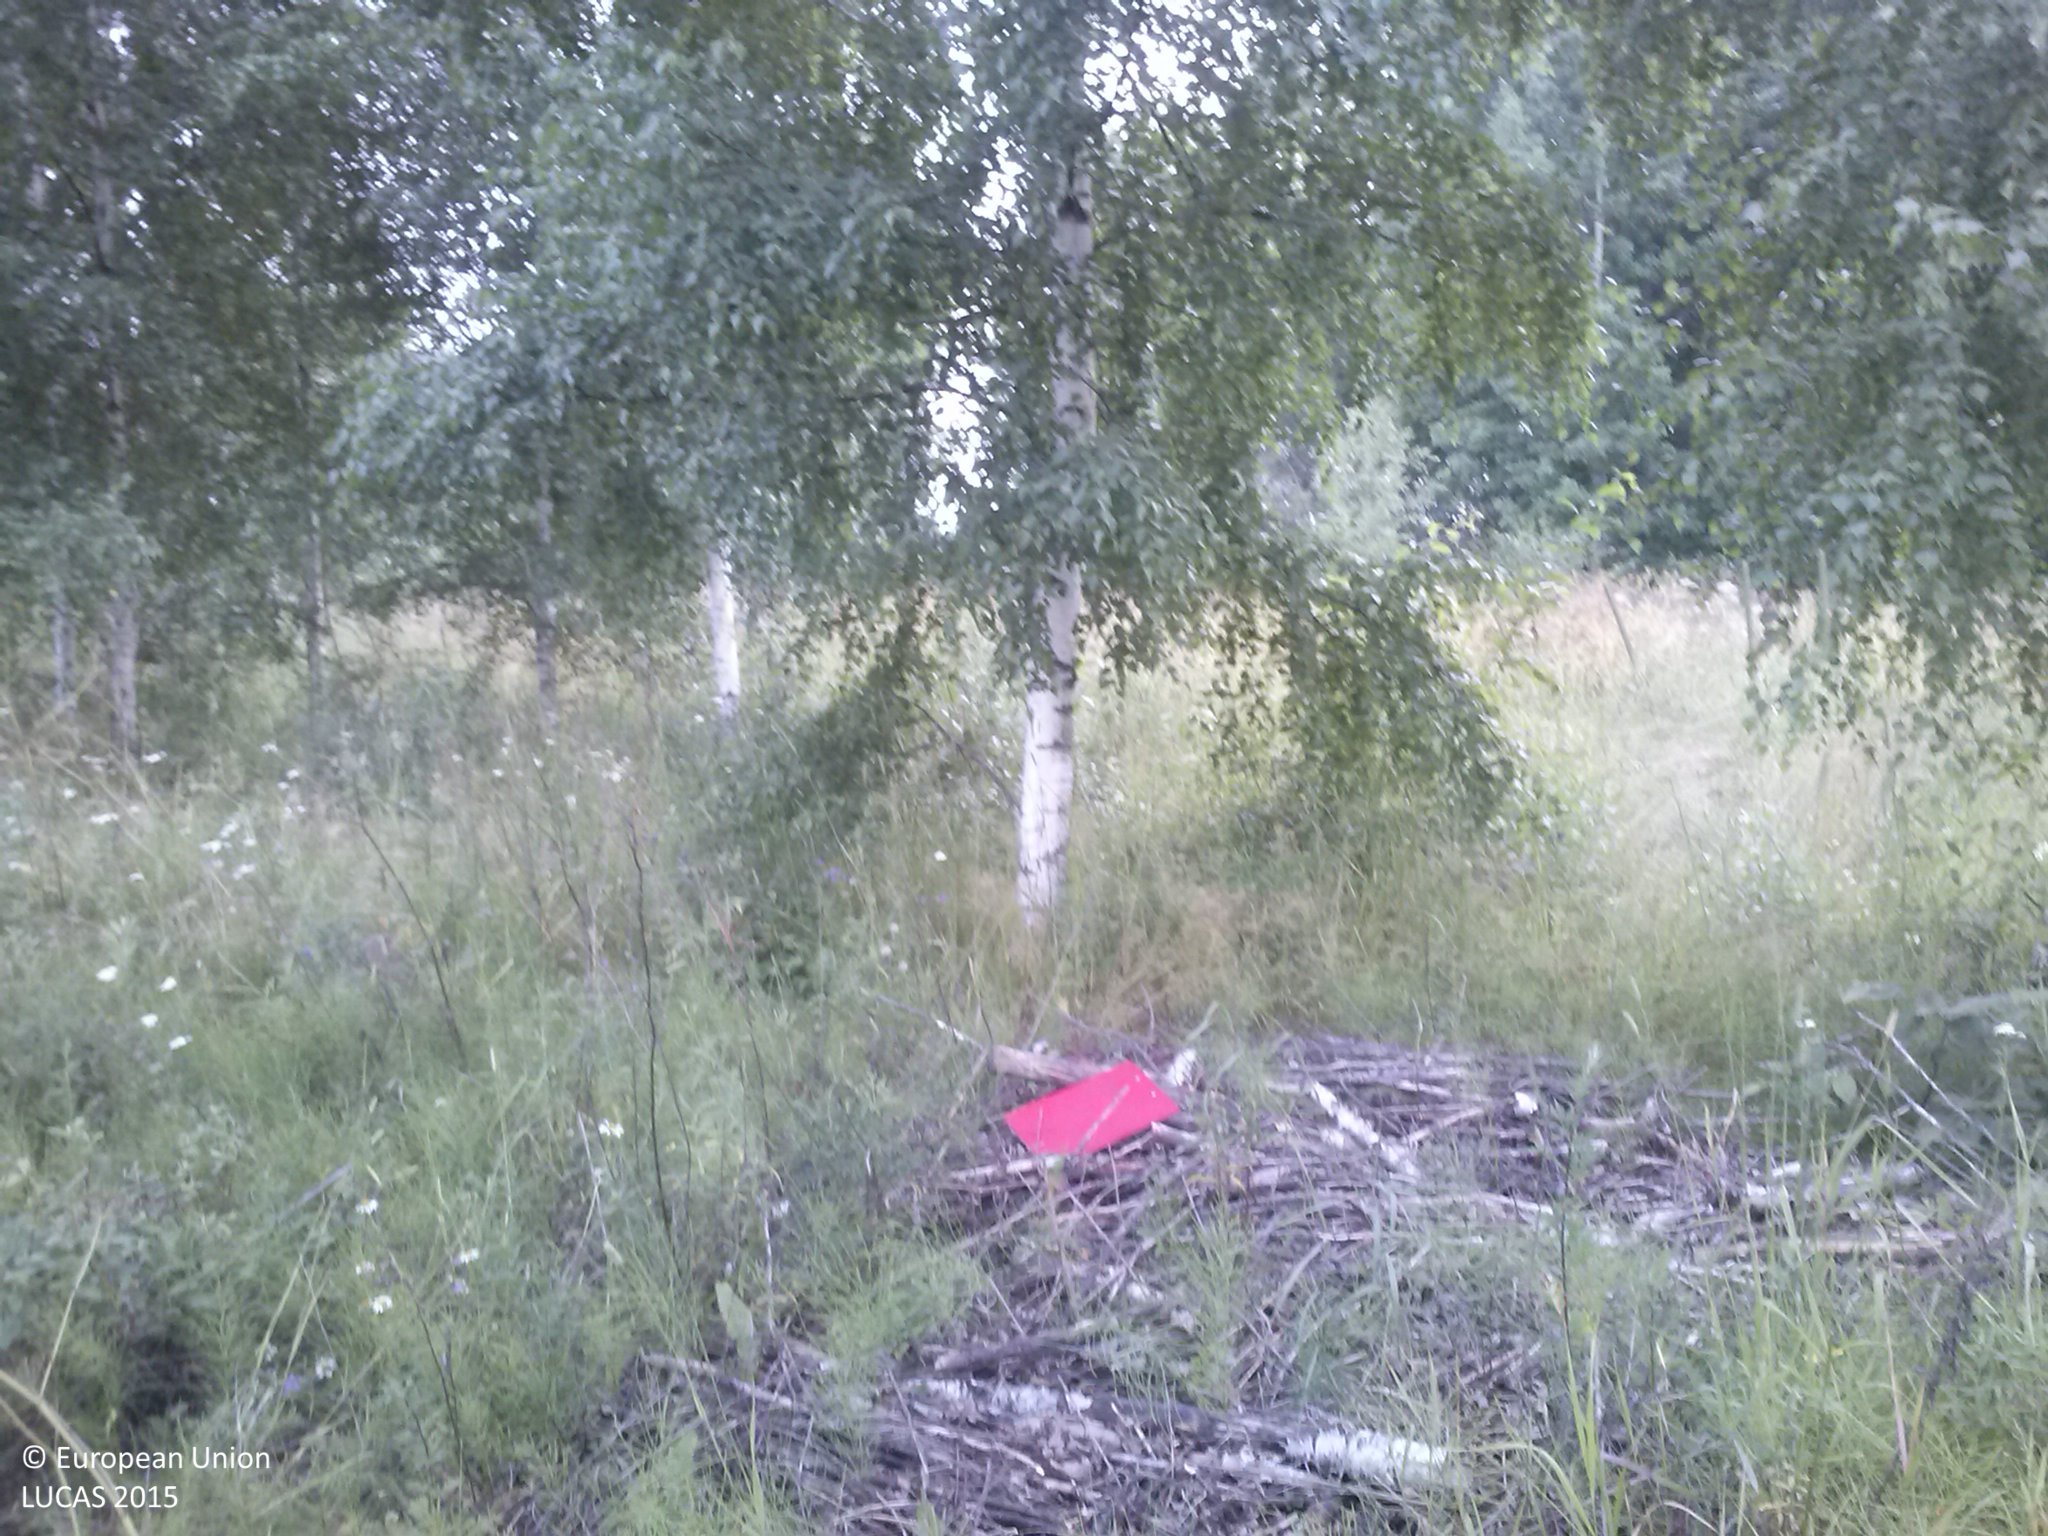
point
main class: Woodland
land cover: Broadleaved woodland
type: non-riverine alder, birch or aspen forest
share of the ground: 50 - 75 %
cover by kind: broadleaved forest trees 60 %, herbaceous plants 30 %
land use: Forestry
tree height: > 5 m
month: July
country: LV
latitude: 56.6694
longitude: 27.0870
